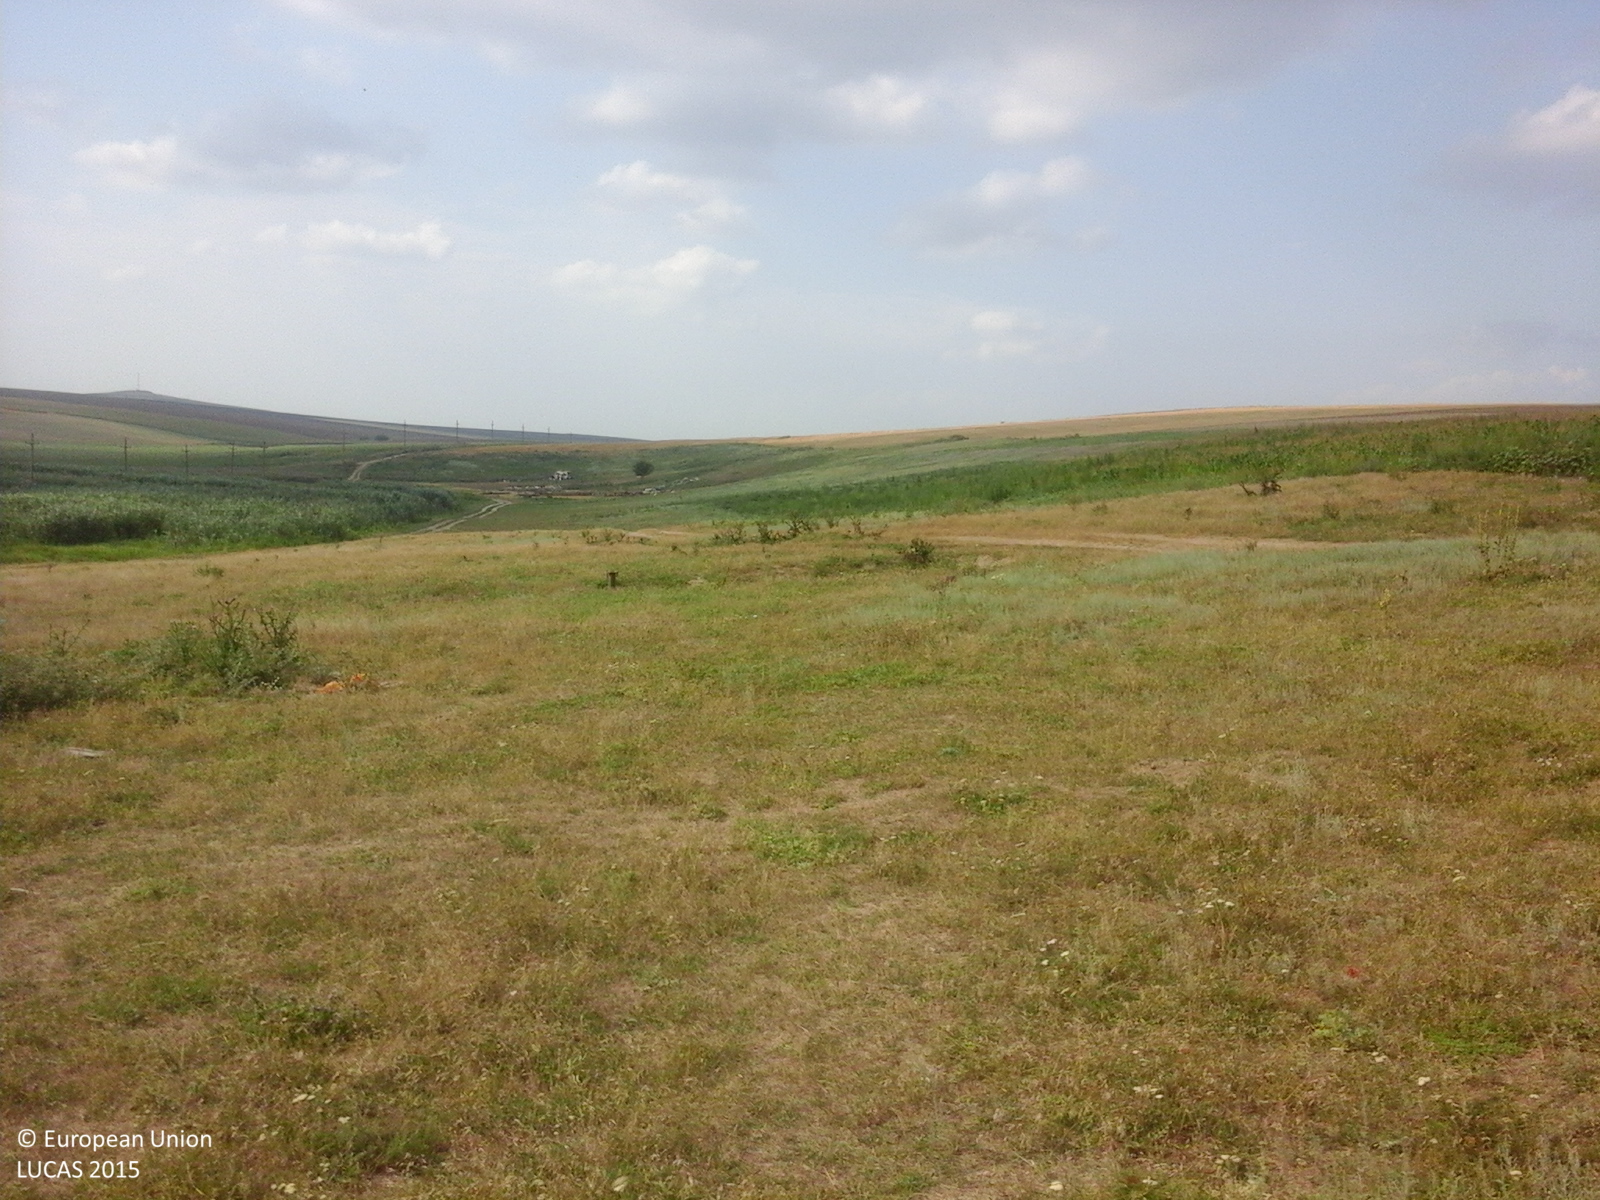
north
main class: Grassland
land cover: Grassland without tree/shrub cover
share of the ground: > 75 %
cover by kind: herbaceous plants 100 %
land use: Agriculture (excluding fallow land and kitchen gardens)
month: July
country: RO
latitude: 45.0795
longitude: 28.8539
